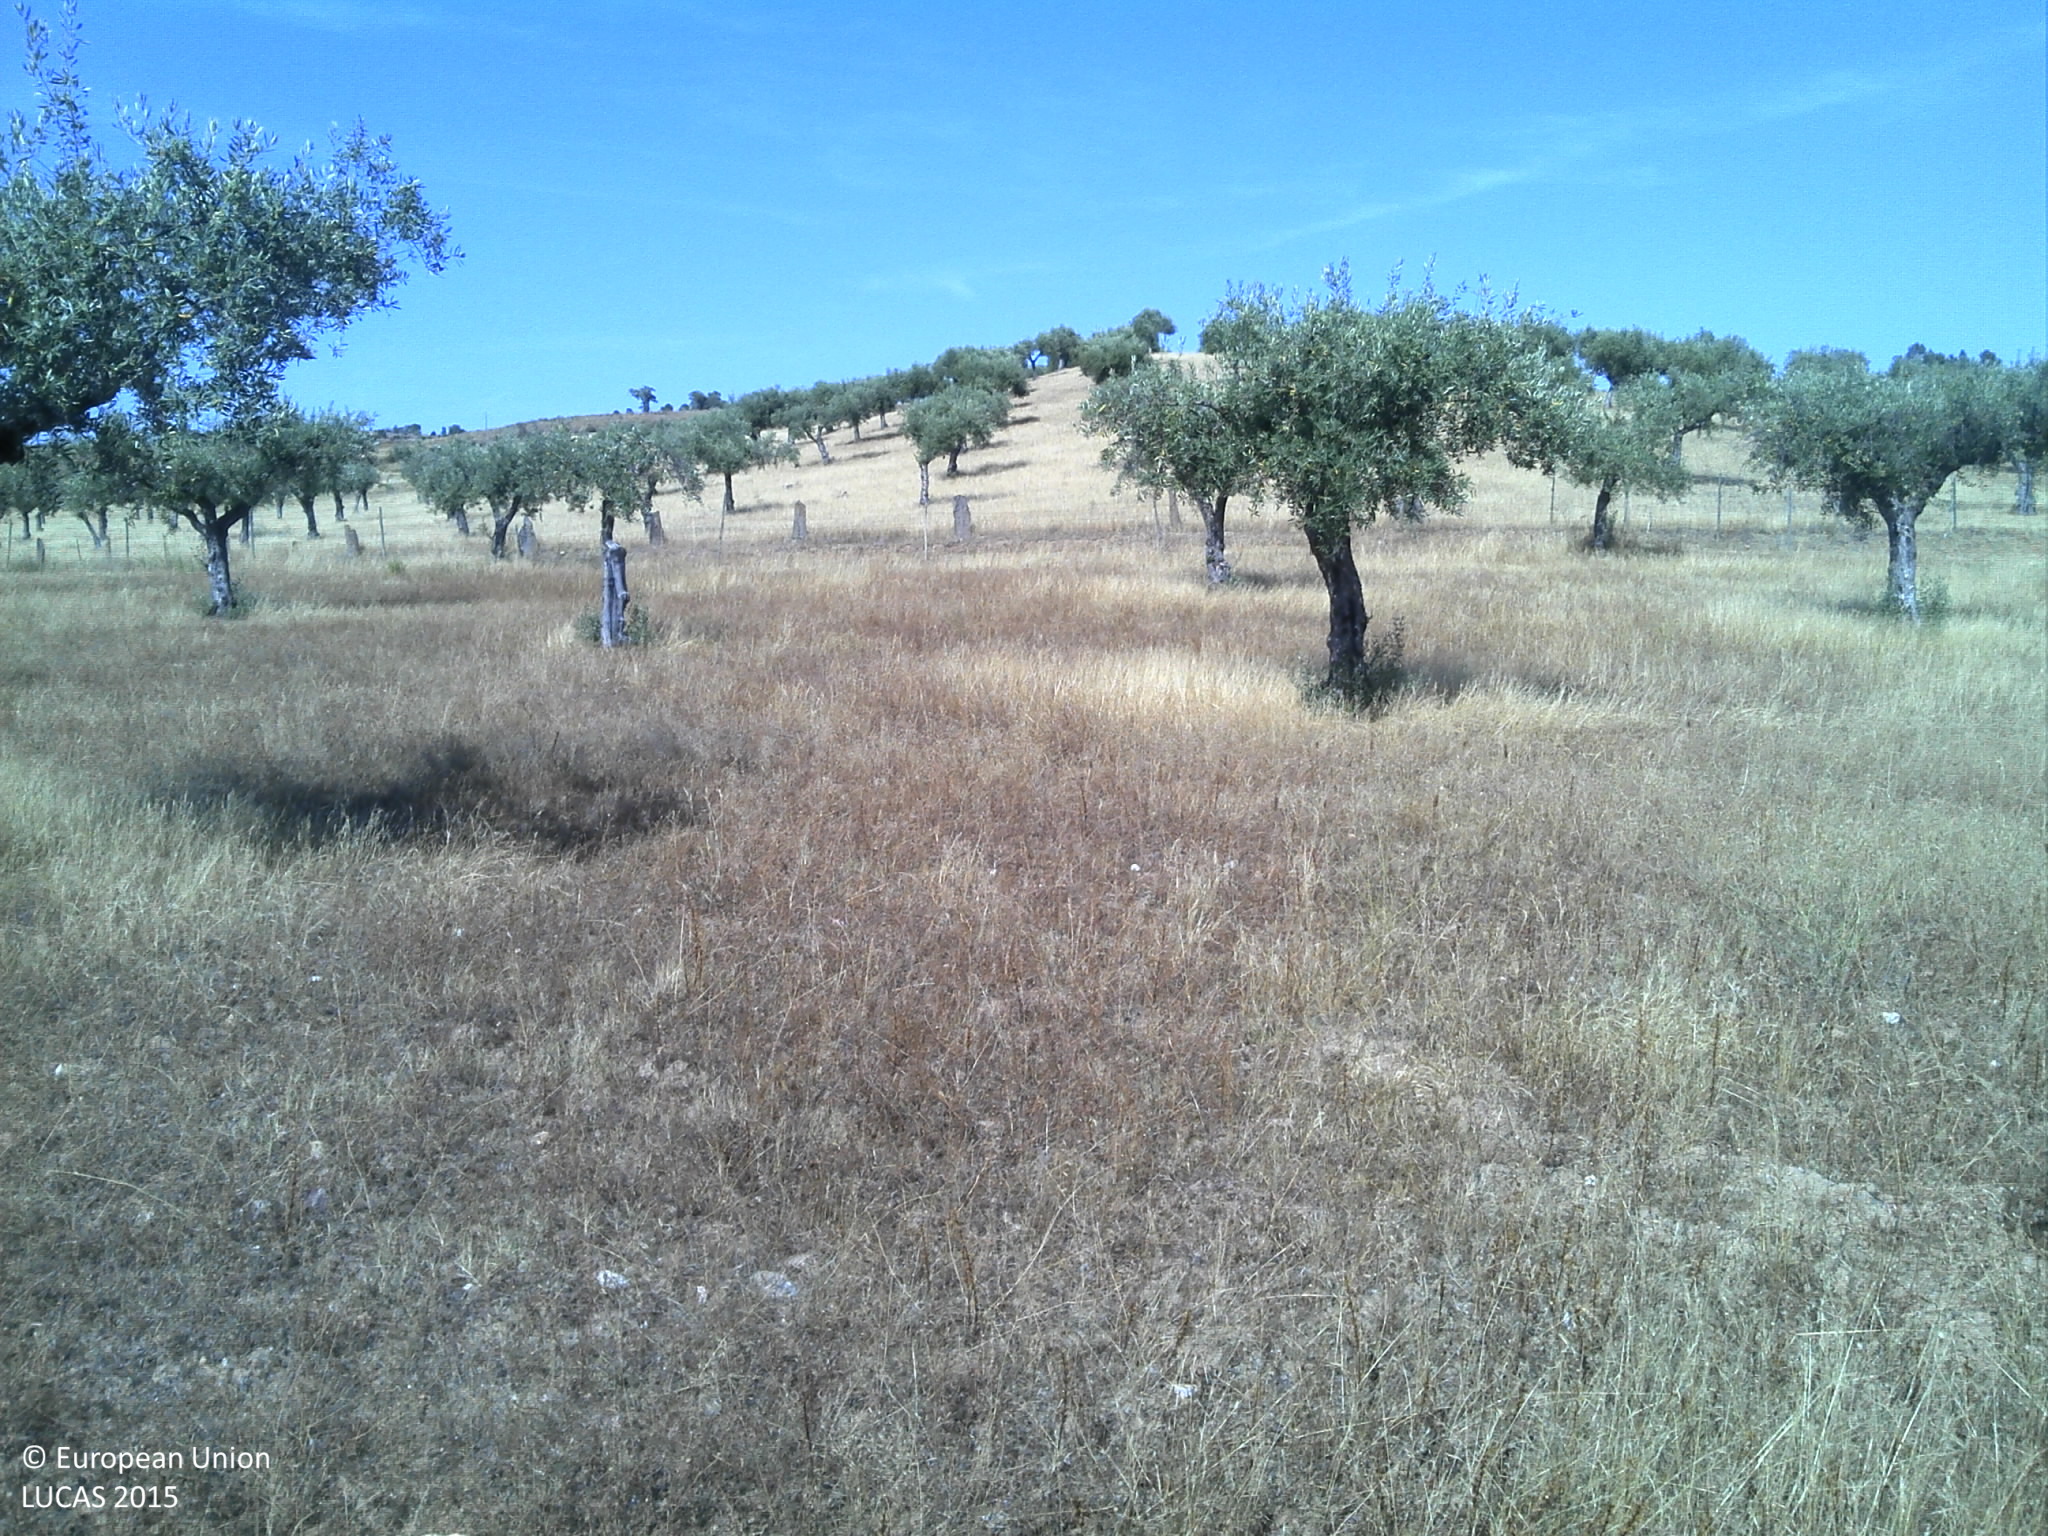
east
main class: Cropland
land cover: Olive groves
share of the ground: 25 - 50 %
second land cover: Grassland without tree/shrub cover
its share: 25 - 50 %
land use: Agriculture (excluding fallow land and kitchen gardens)
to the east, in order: Olive groves; Grassland without tree/shrub cover; Olive groves; Fences; Tracks; Fences; Olive groves; Fences; Spontaneously vegetated surfaces; Fences; Ditches and canals; Fences; Olive groves
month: July
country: PT
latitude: 39.6996
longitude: -7.5808
